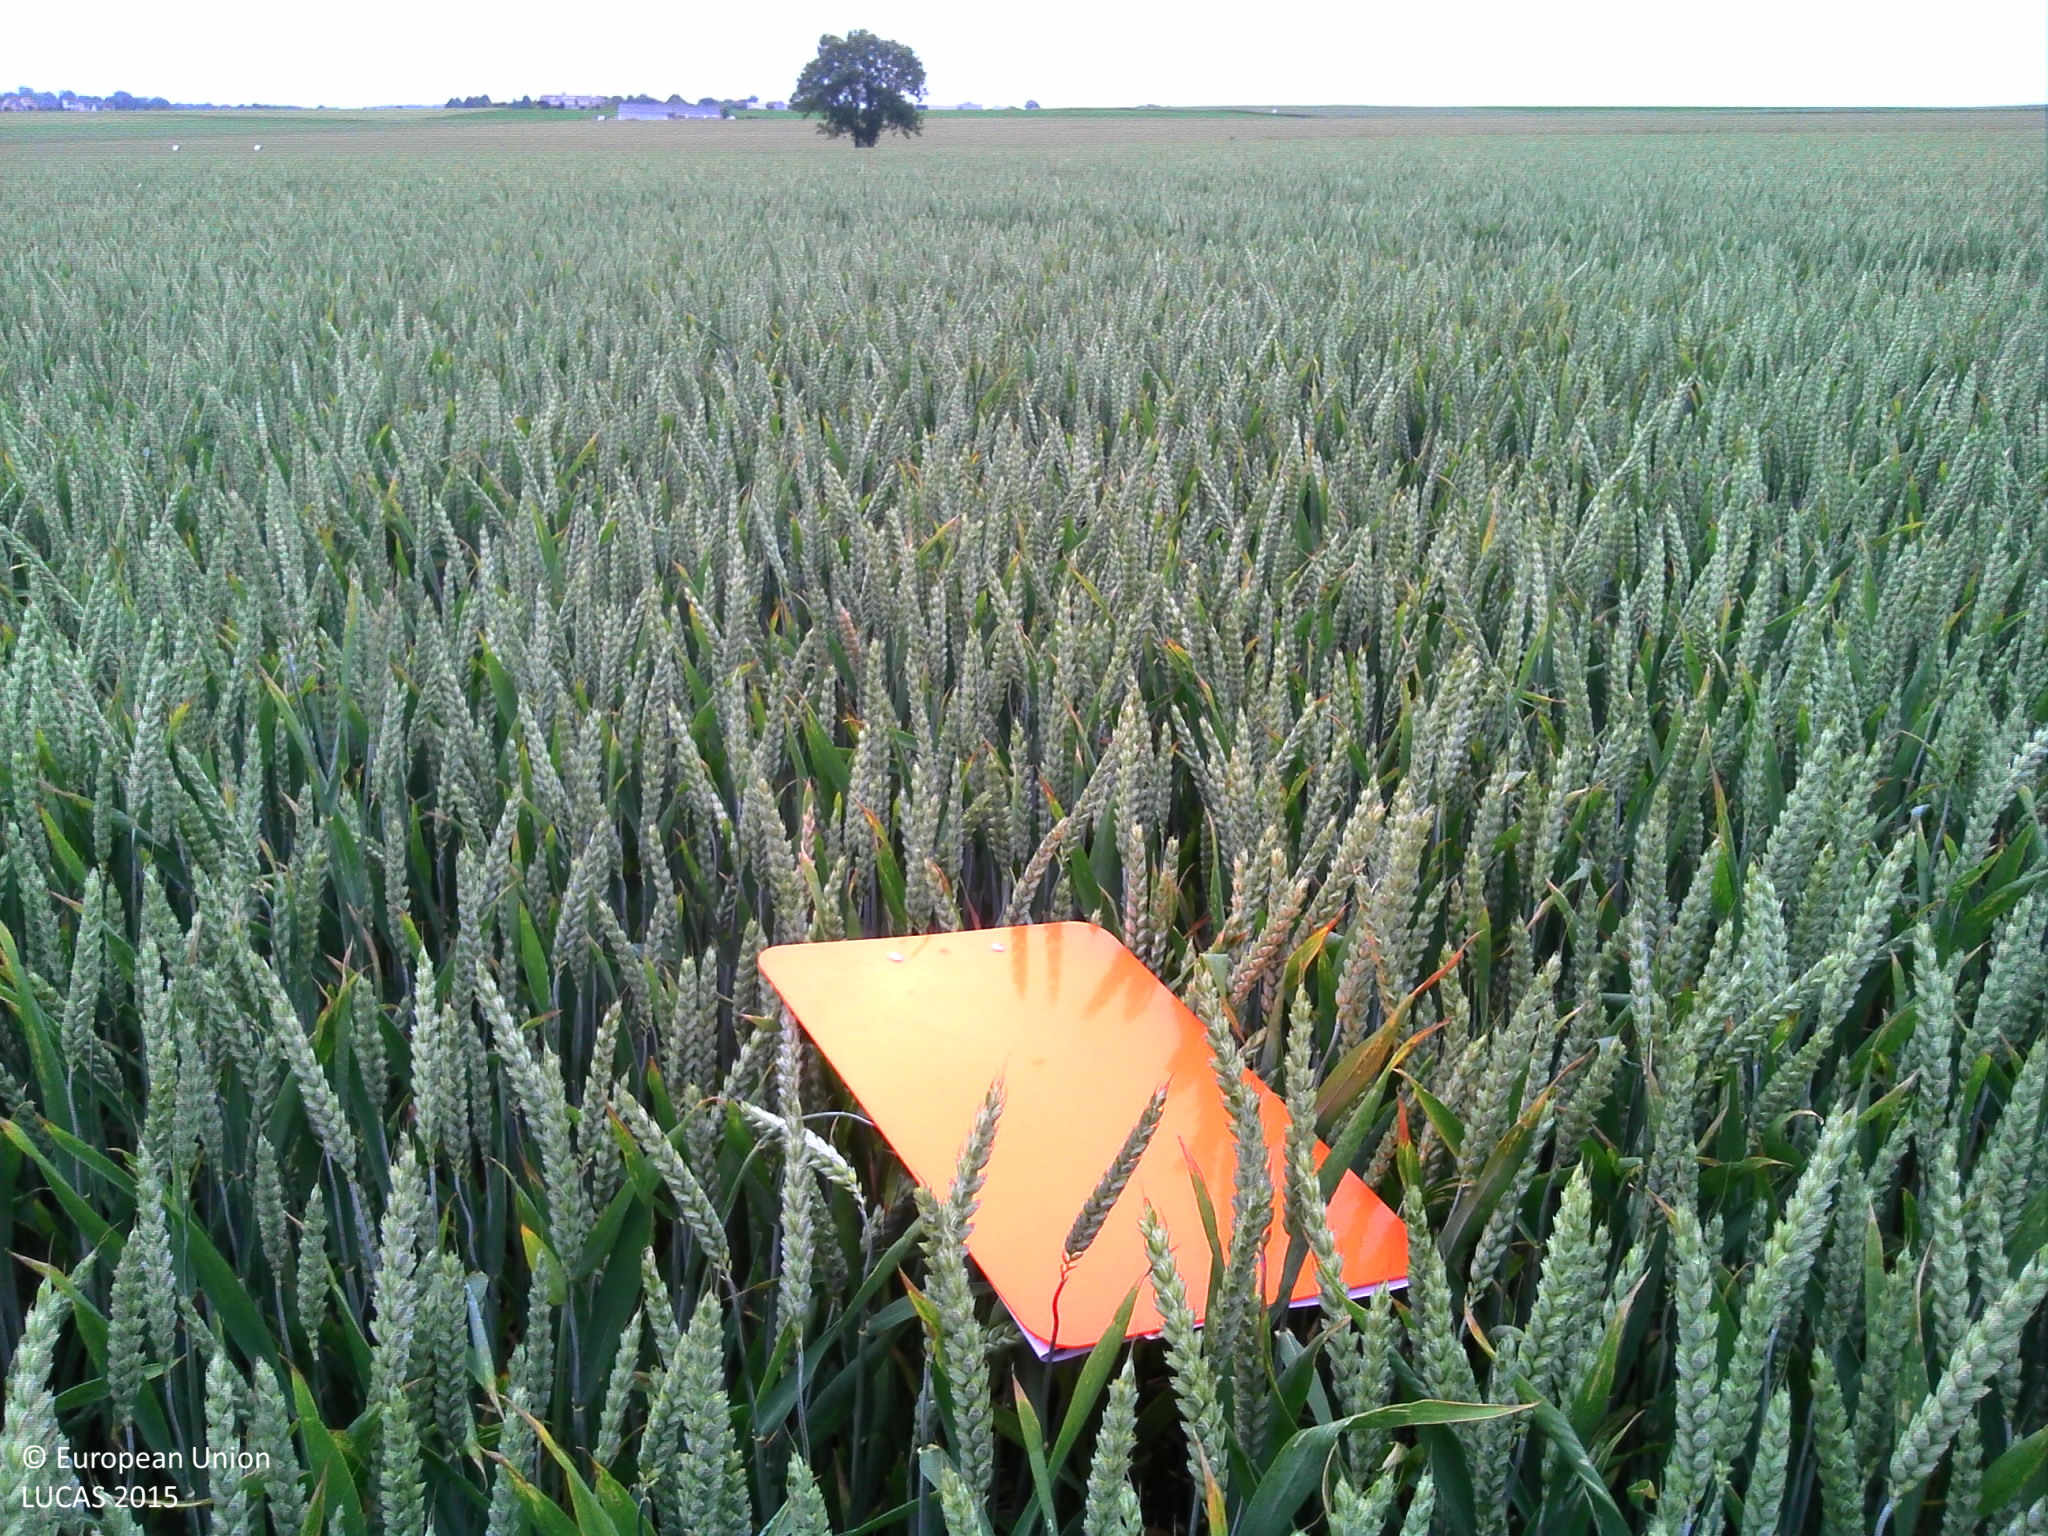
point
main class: Cropland
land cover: Common wheat
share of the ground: > 75 %
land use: Agriculture (excluding fallow land and kitchen gardens)
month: June
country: FR
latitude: 49.2327
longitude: -0.2373
